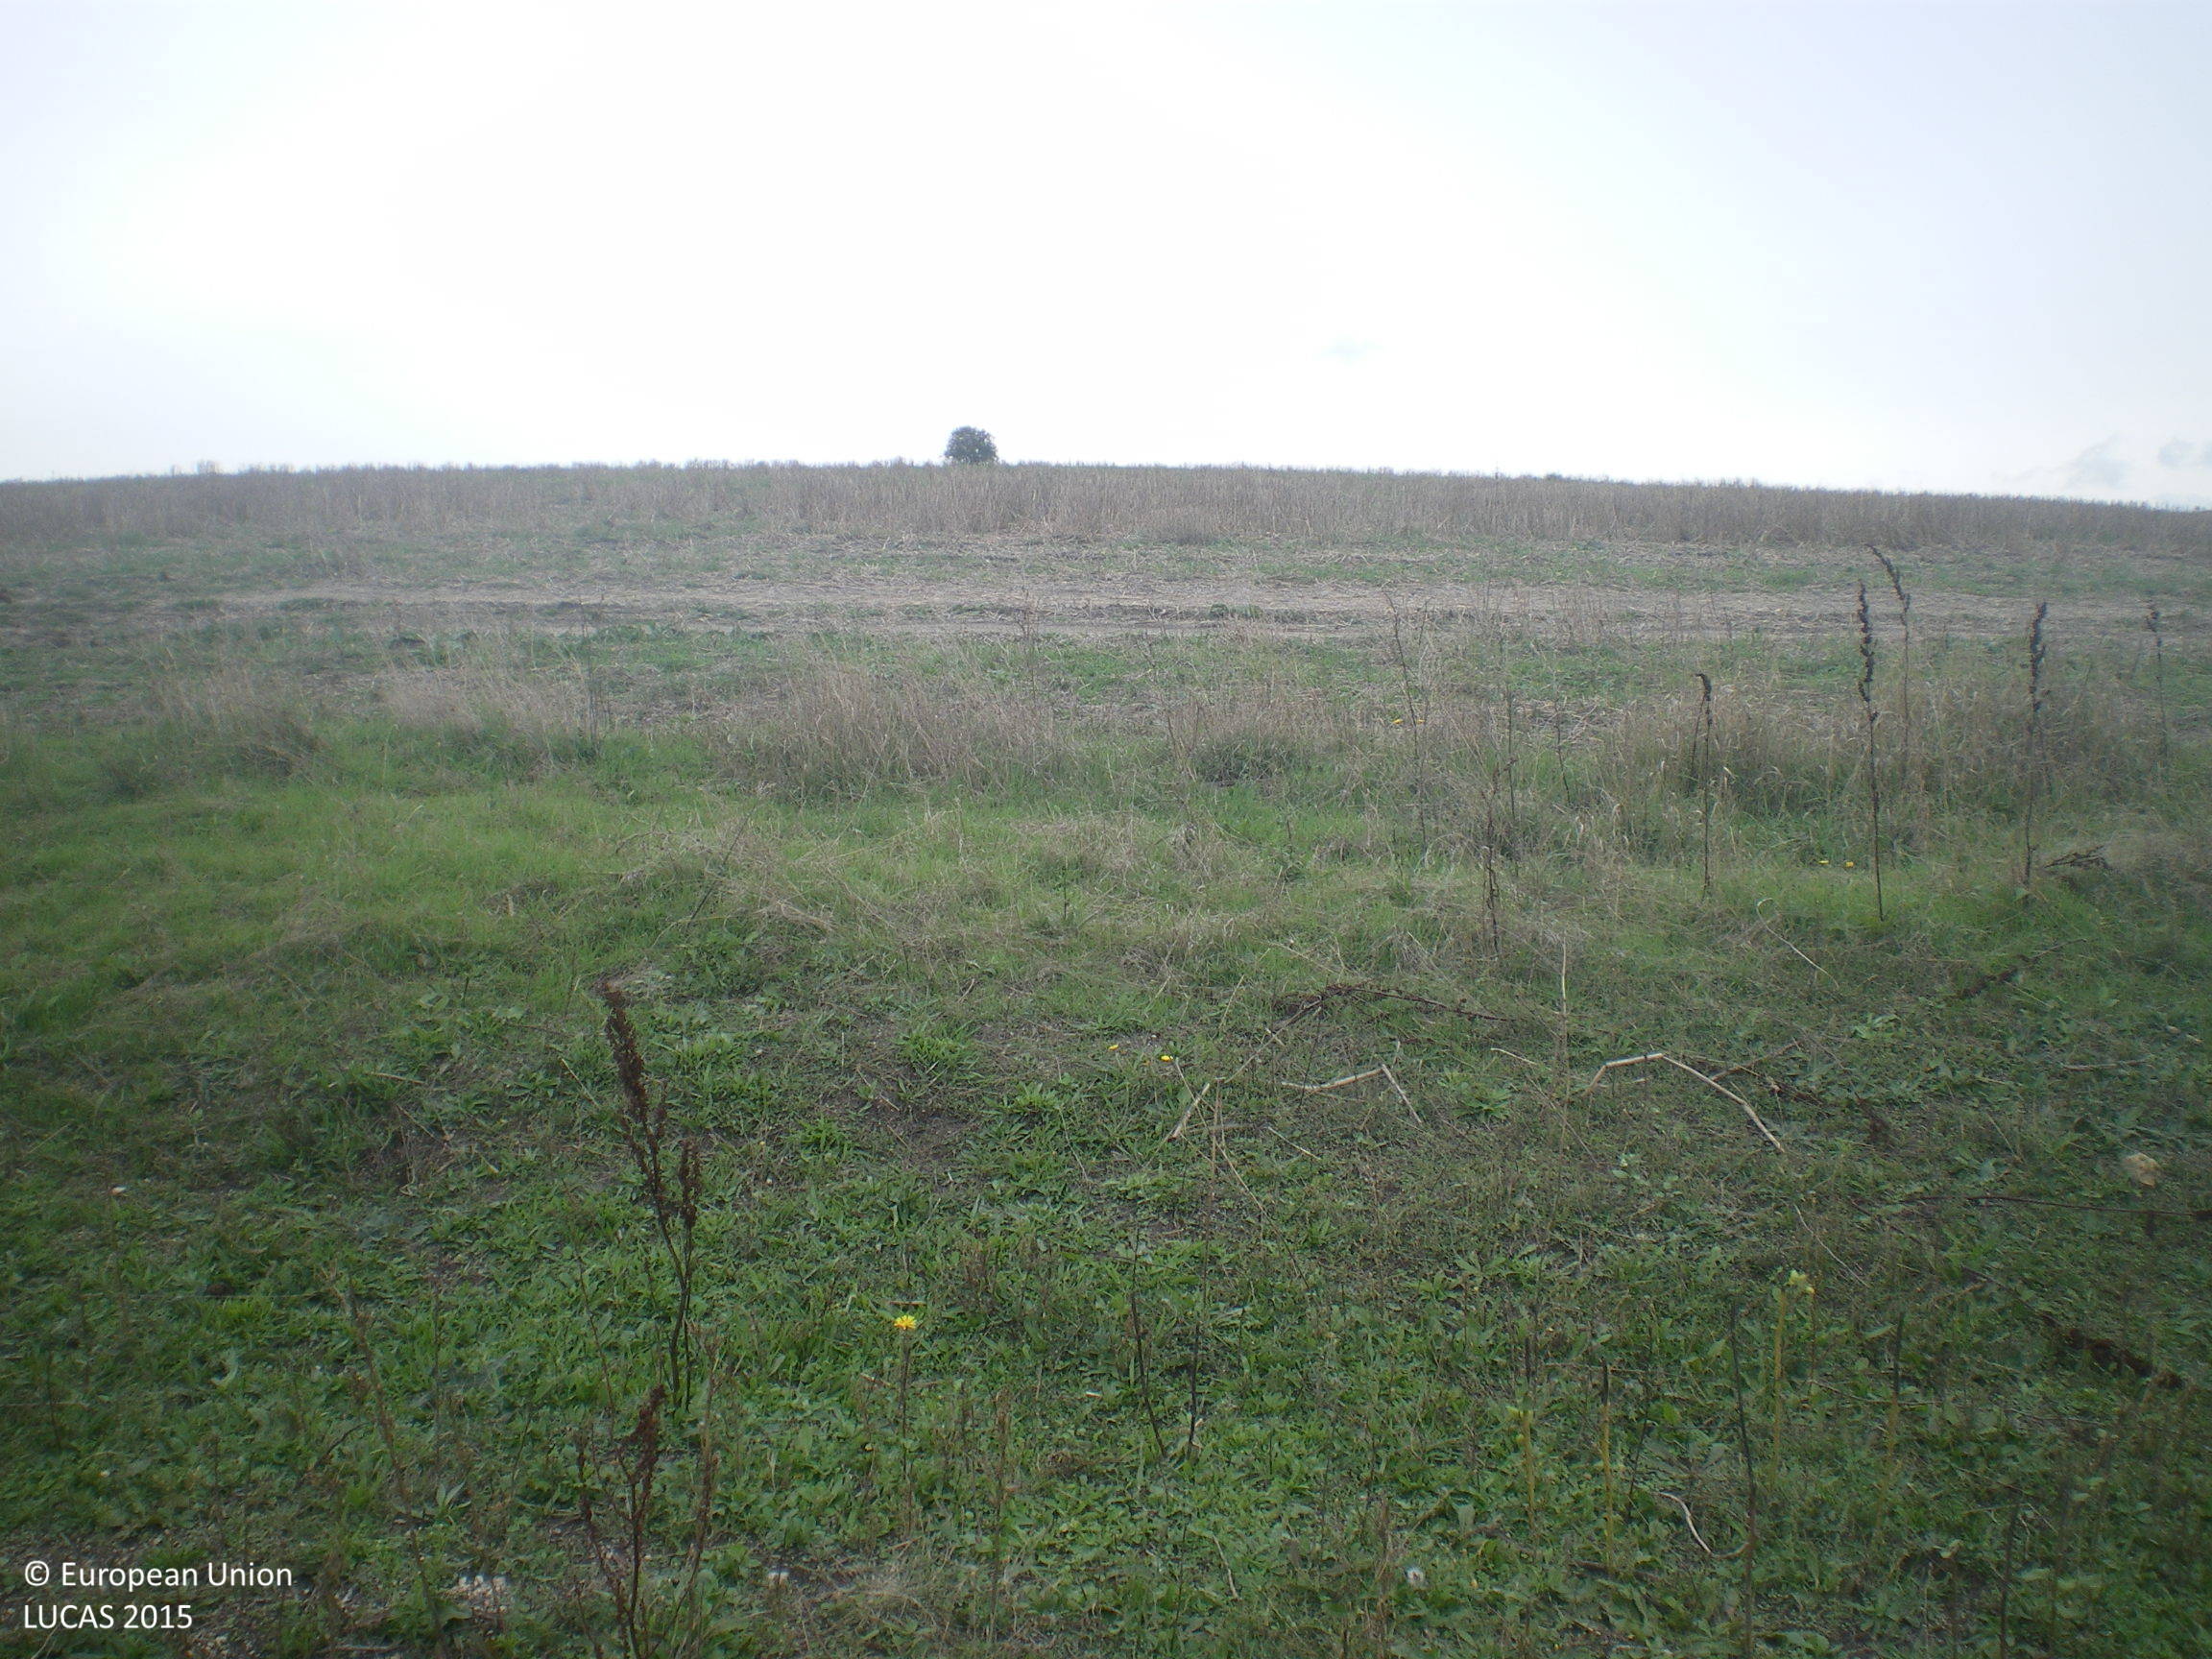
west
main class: Grassland
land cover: Grassland with sparse tree/shrub cover
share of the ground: > 75 %
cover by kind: herbaceous plants 90 %, broadleaved forest trees 5 %, shrubs 5 %
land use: Semi-natural and natural areas not in use
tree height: > 5 m
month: October
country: BG
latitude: 41.9371
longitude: 26.0309
